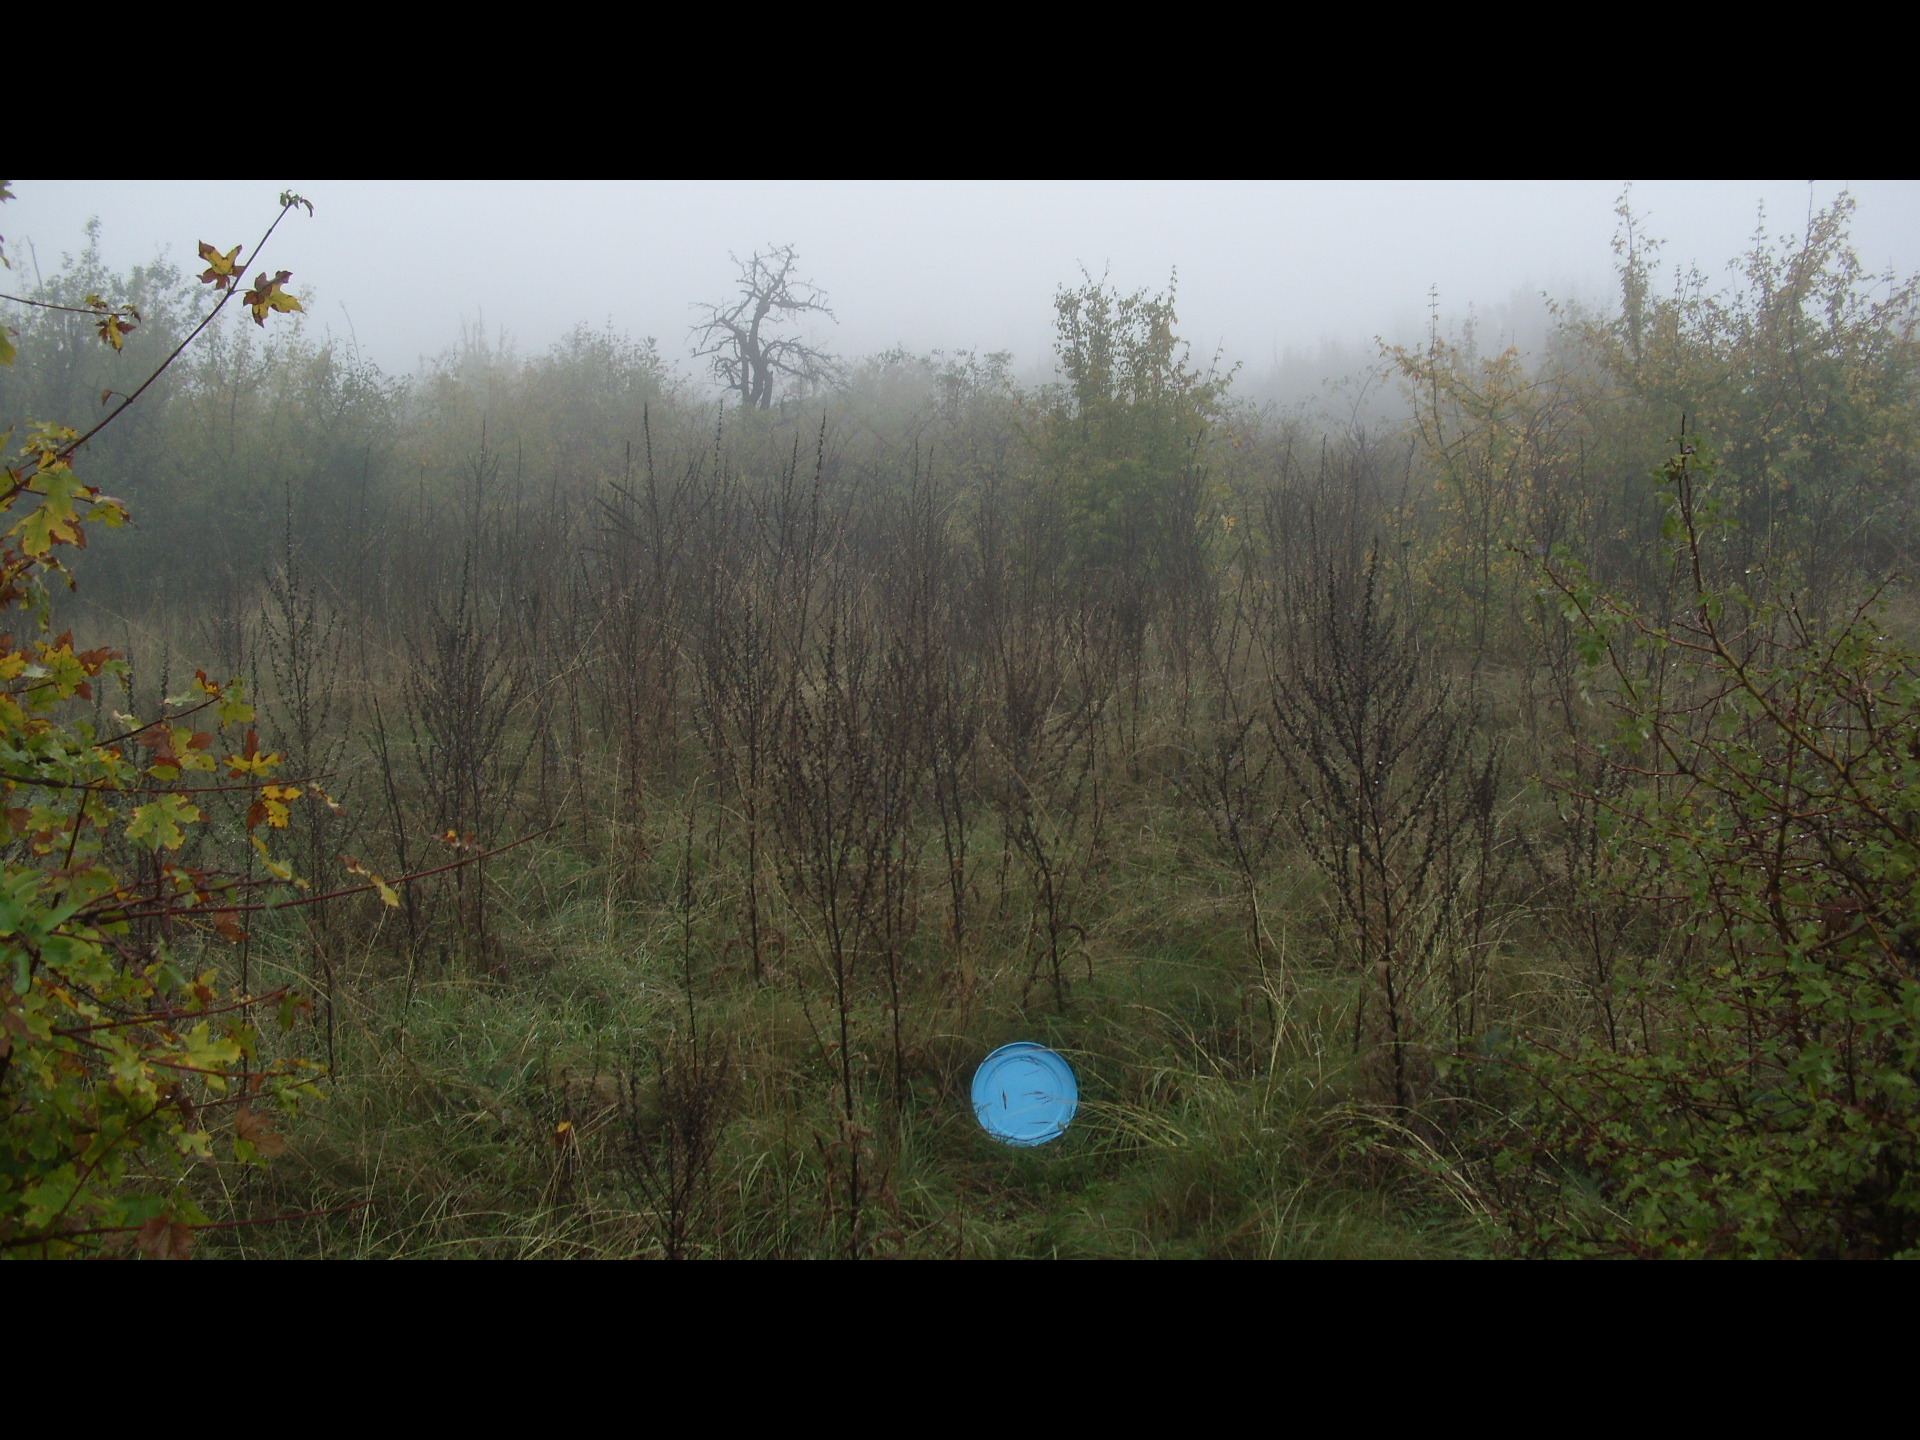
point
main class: Grassland
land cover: Grassland with sparse tree/shrub cover
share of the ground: > 75 %
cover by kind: herbaceous plants 85 %, shrubs 10 %, broadleaved forest trees 5 %
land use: Semi-natural and natural areas not in use
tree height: < 5 m
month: October
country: BG
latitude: 43.7628
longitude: 22.4408
